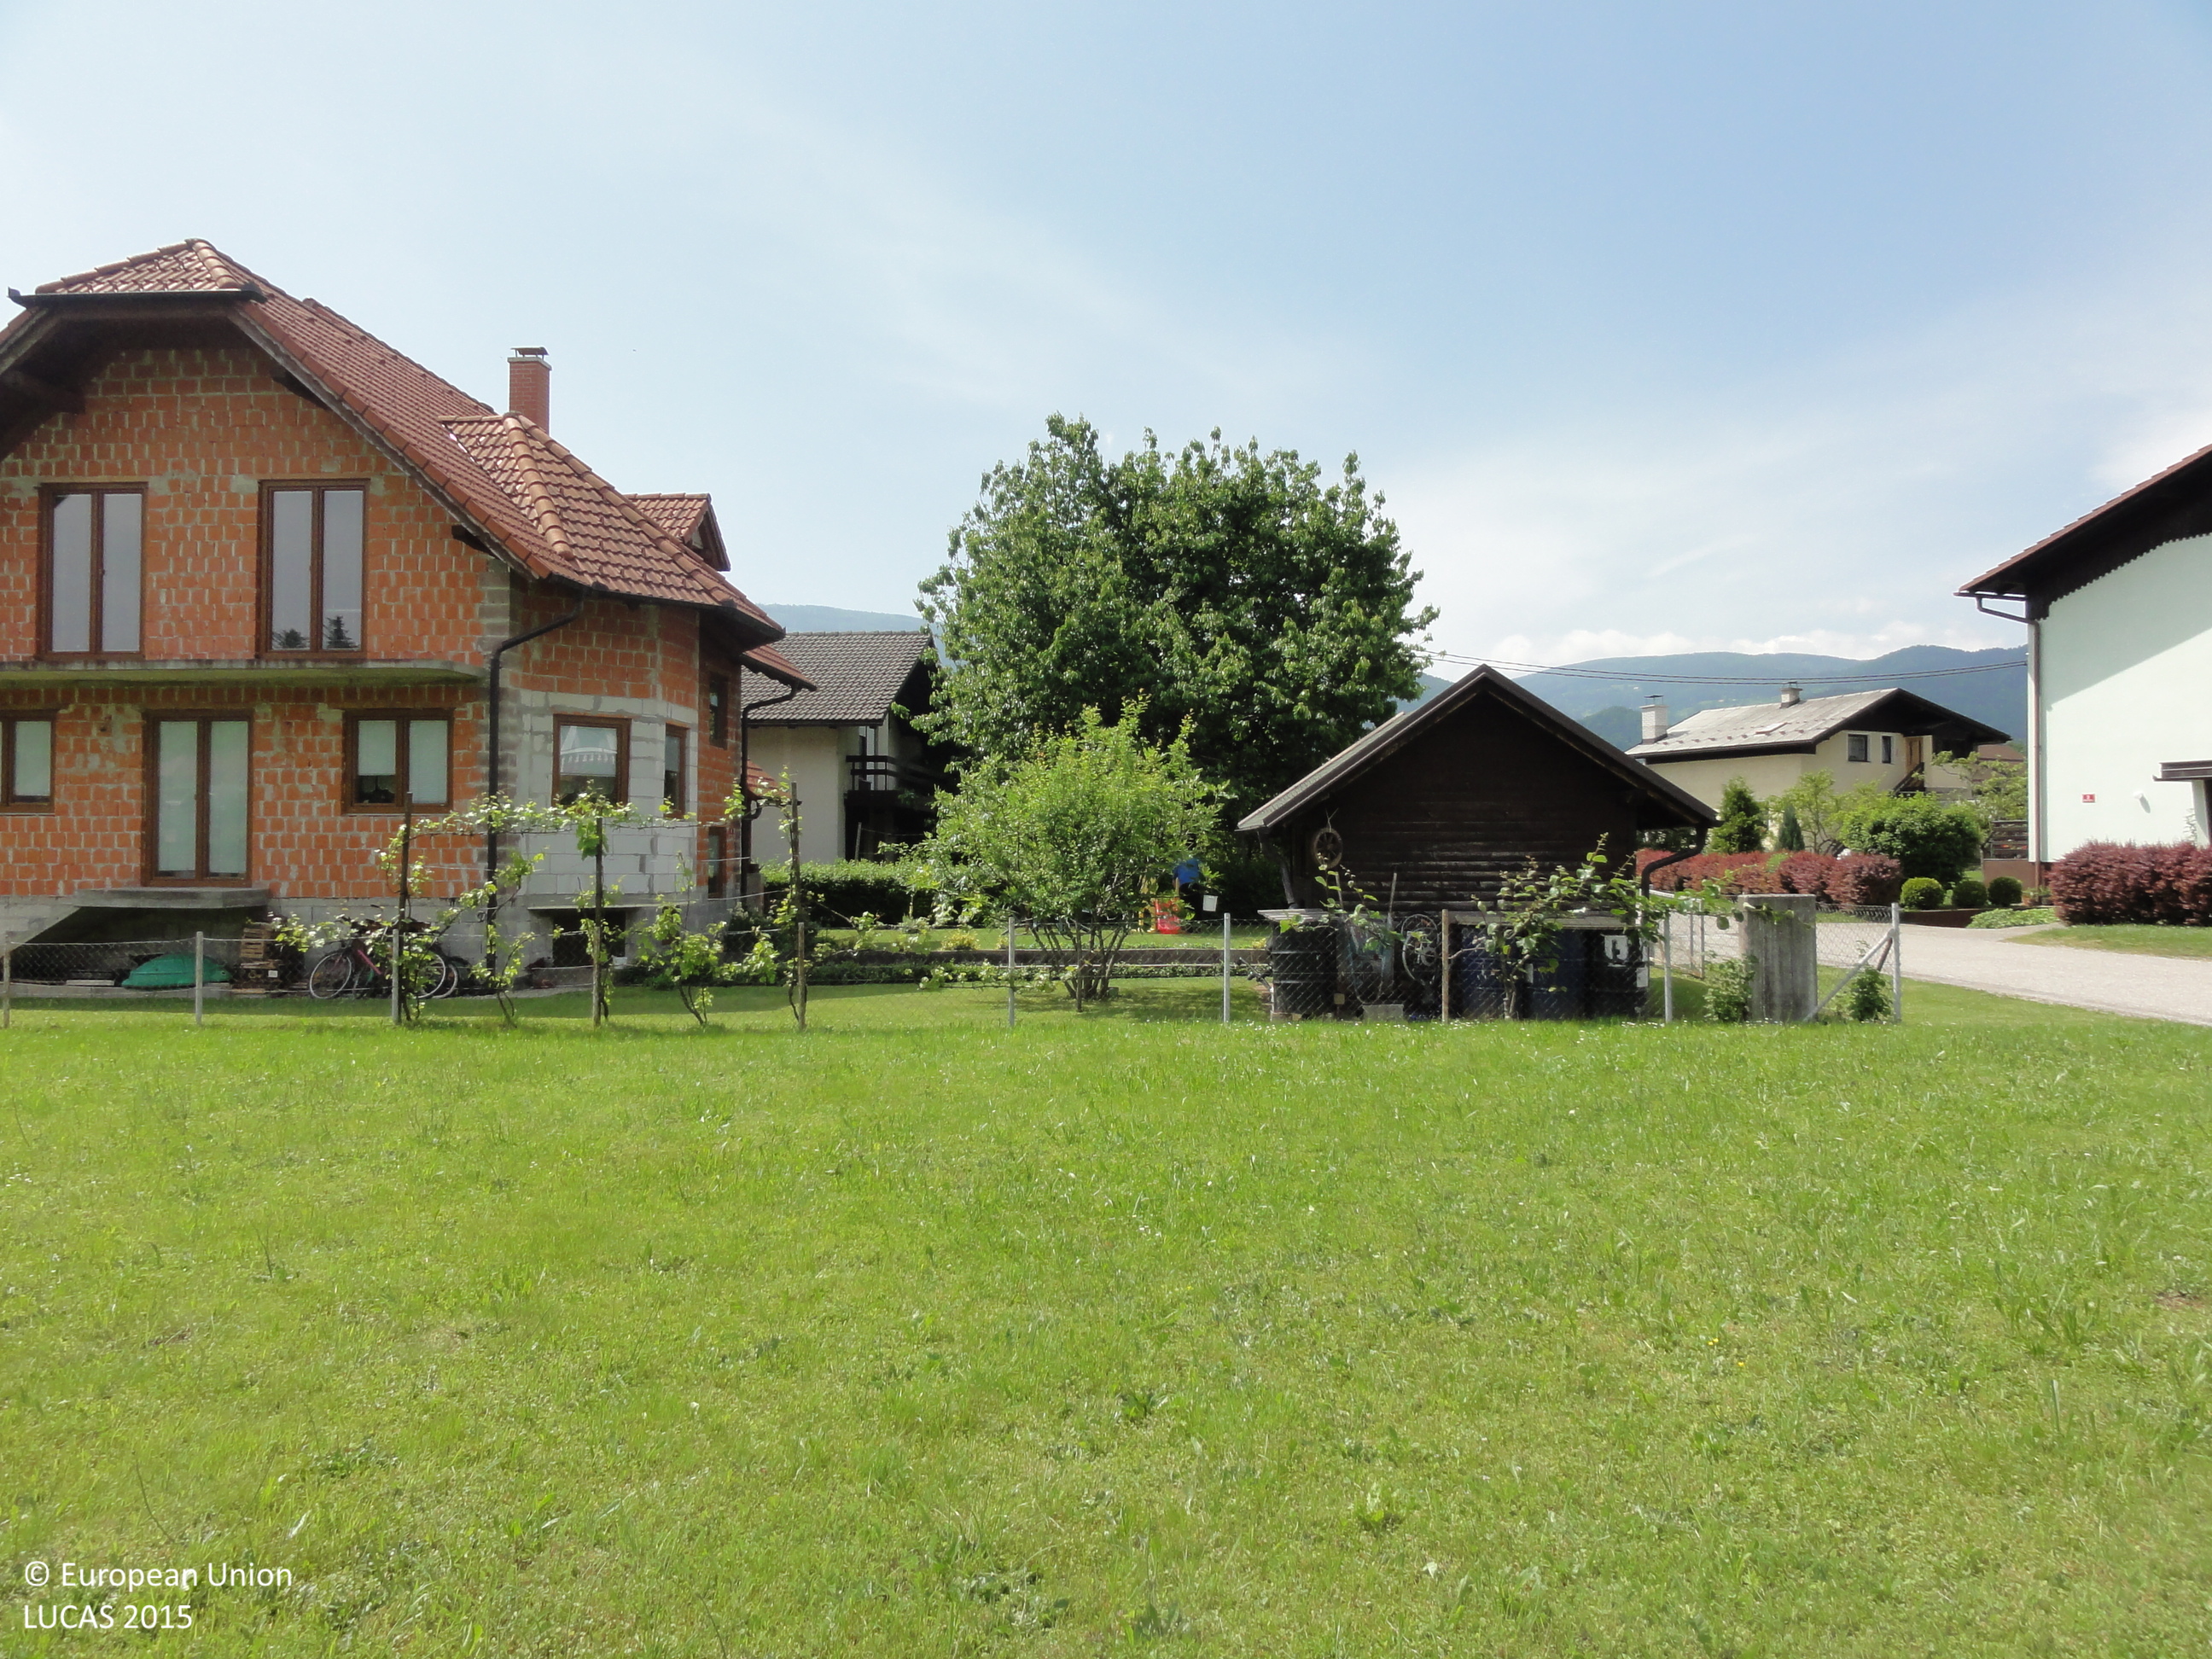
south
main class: Grassland
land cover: Grassland without tree/shrub cover
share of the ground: > 75 %
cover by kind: herbaceous plants 100 %
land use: Agriculture (excluding fallow land and kitchen gardens)
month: May
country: SI
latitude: 46.5532
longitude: 15.4899
